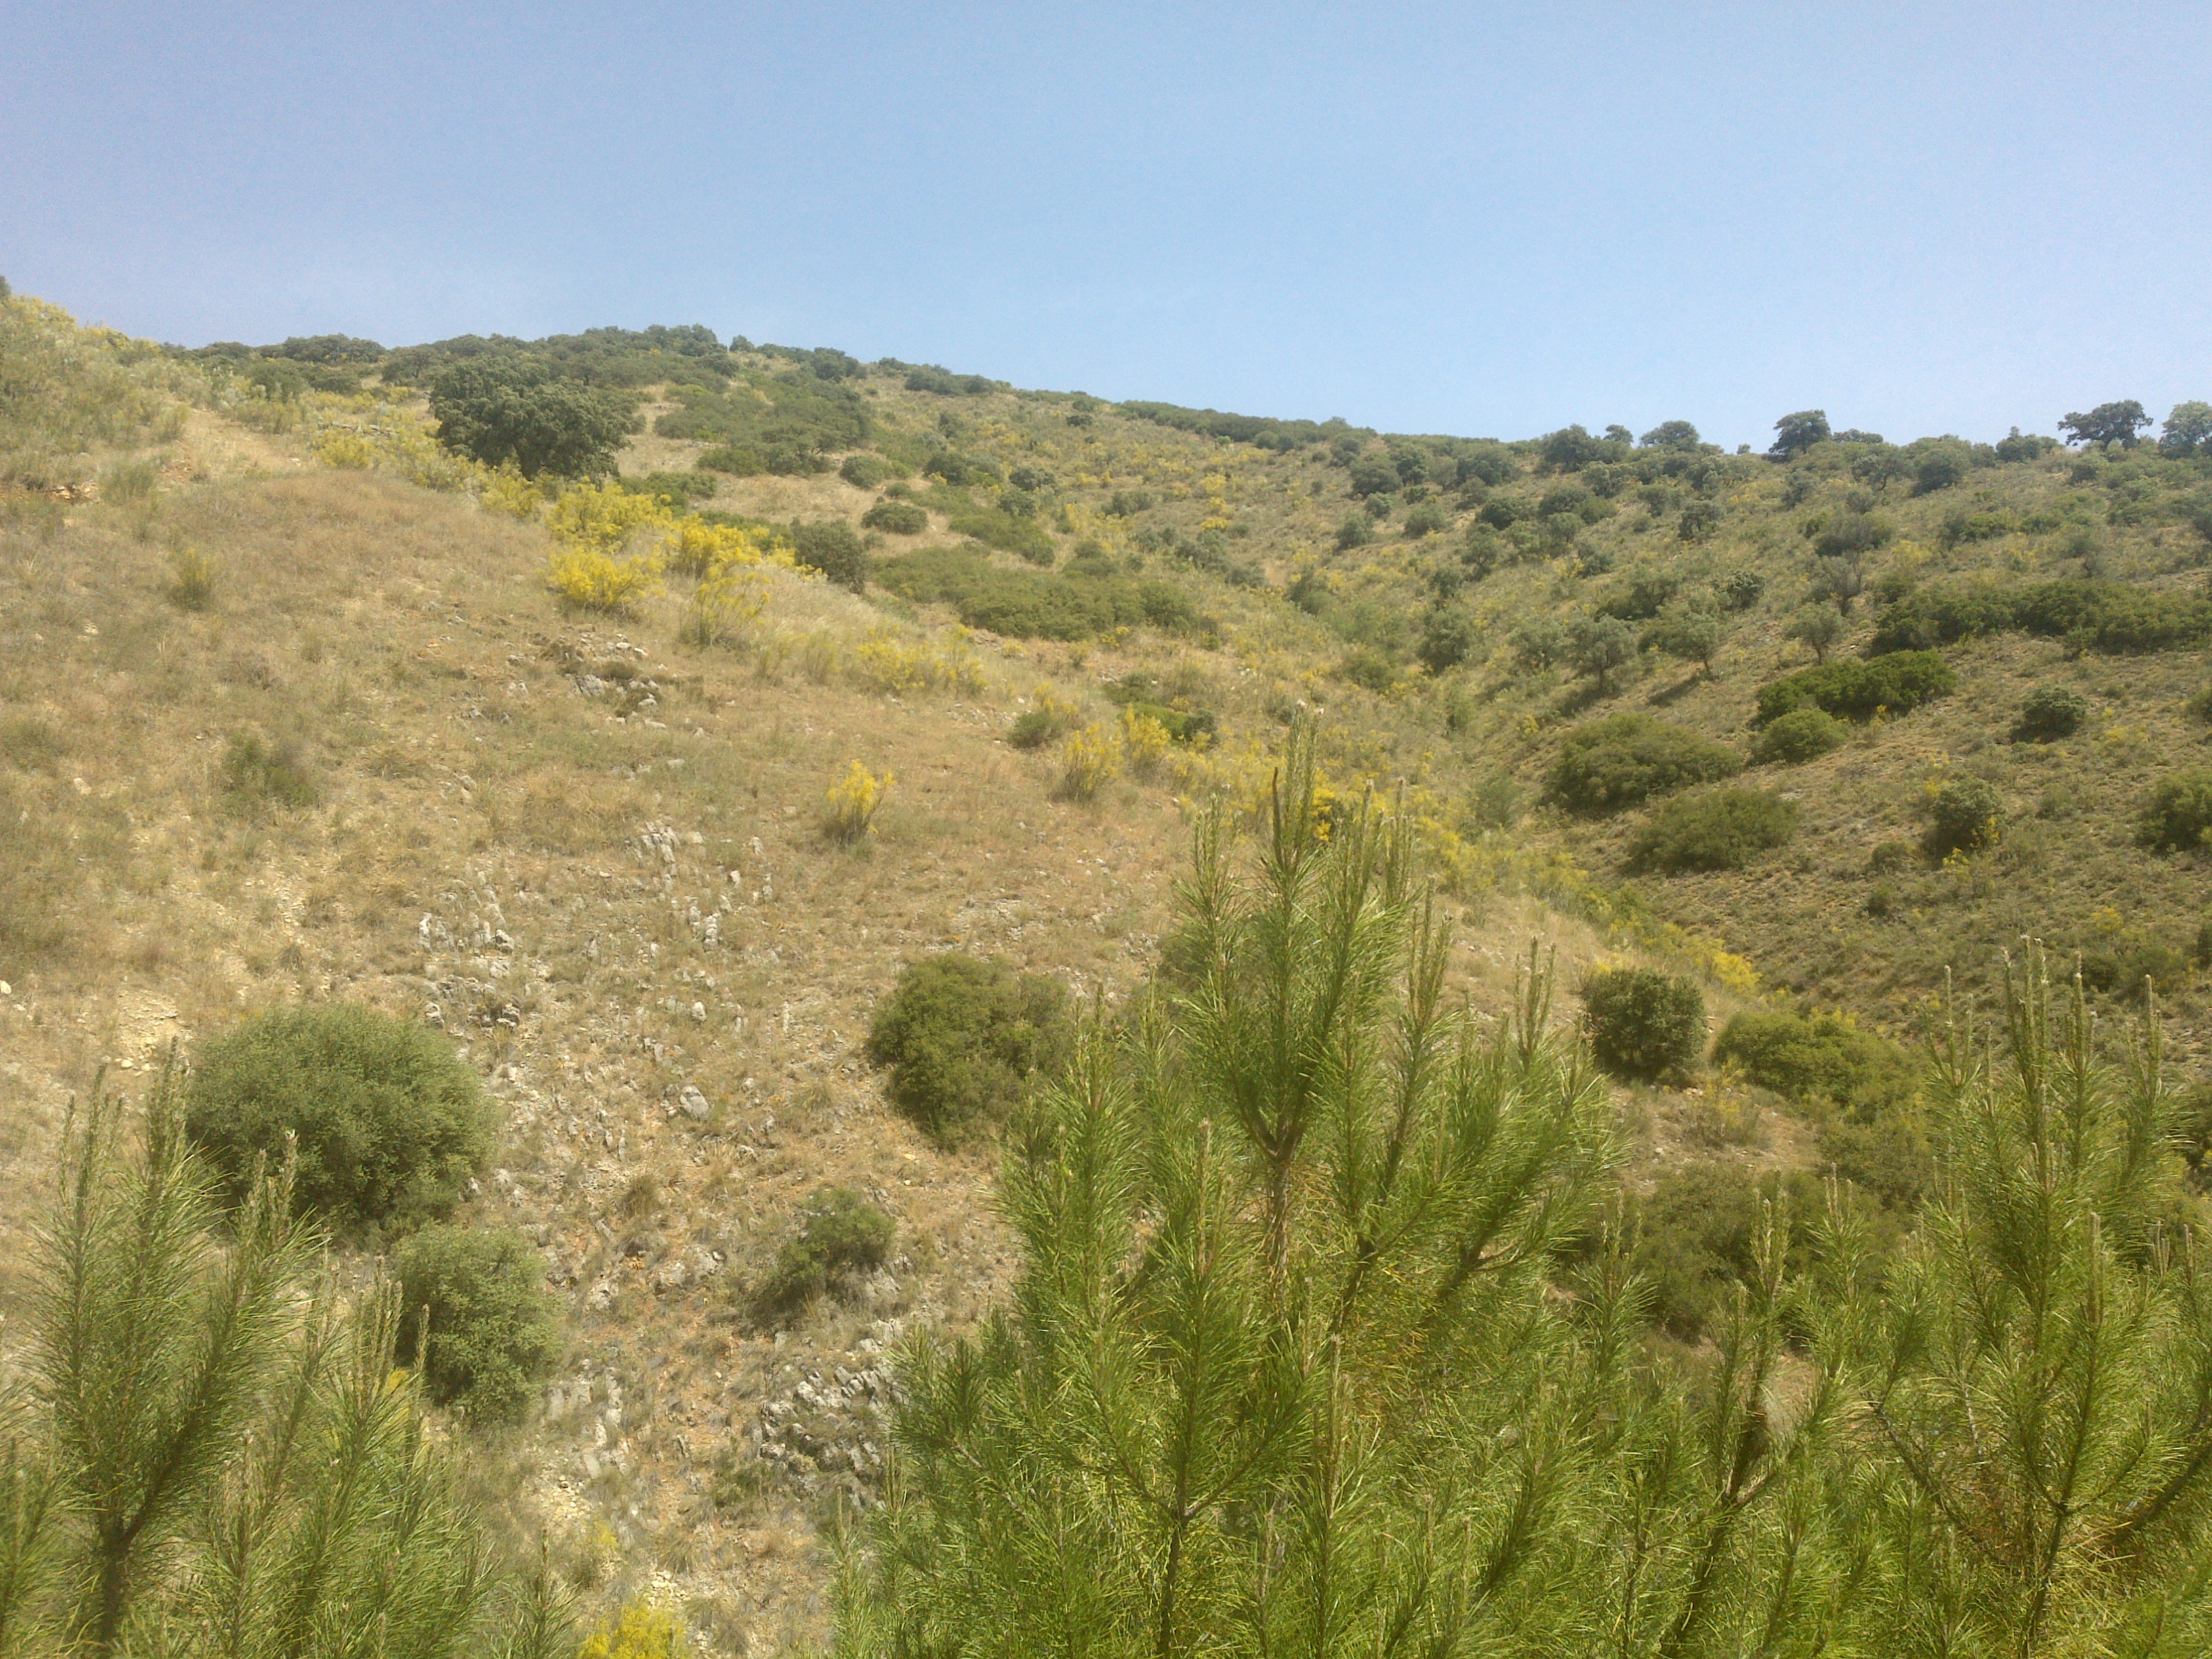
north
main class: Shrubland
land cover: Shrubland without tree cover
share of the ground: 25 - 50 %
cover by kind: herbaceous plants 70 %, shrubs 25 %, unconsolidated bare surface 5 %
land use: Semi-natural and natural areas not in use
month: May
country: ES
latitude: 37.4111
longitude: -4.2011
